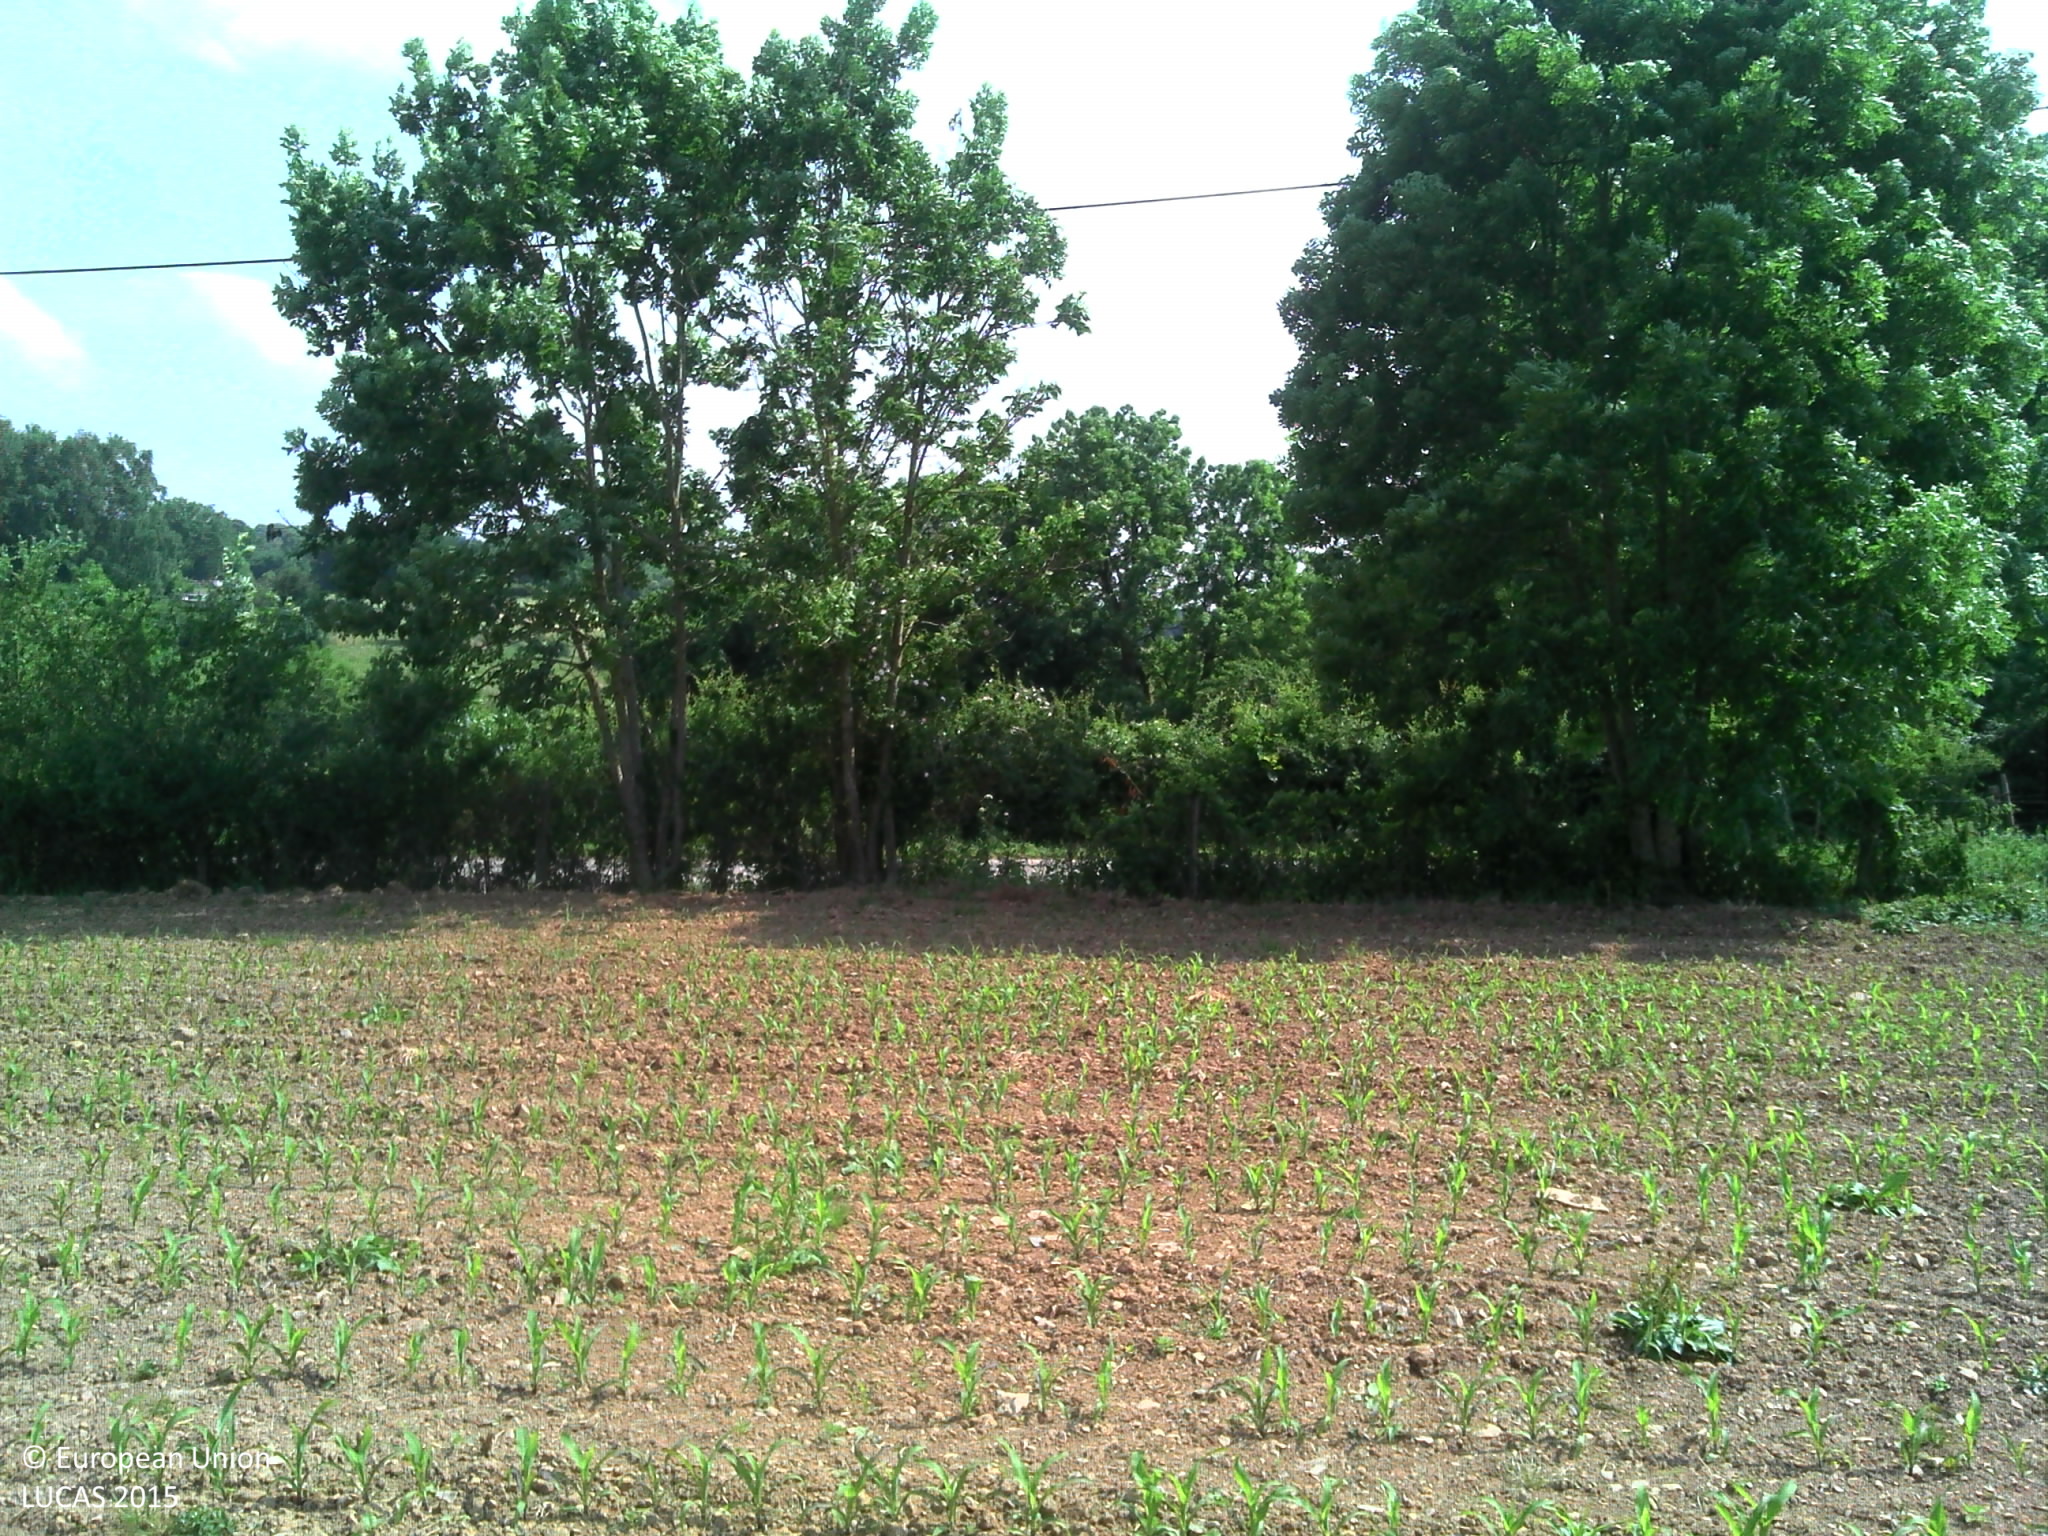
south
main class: Cropland
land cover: Maize
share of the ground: < 10 %
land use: Agriculture (excluding fallow land and kitchen gardens)
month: June
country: BE
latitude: 50.2416
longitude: 5.5535
